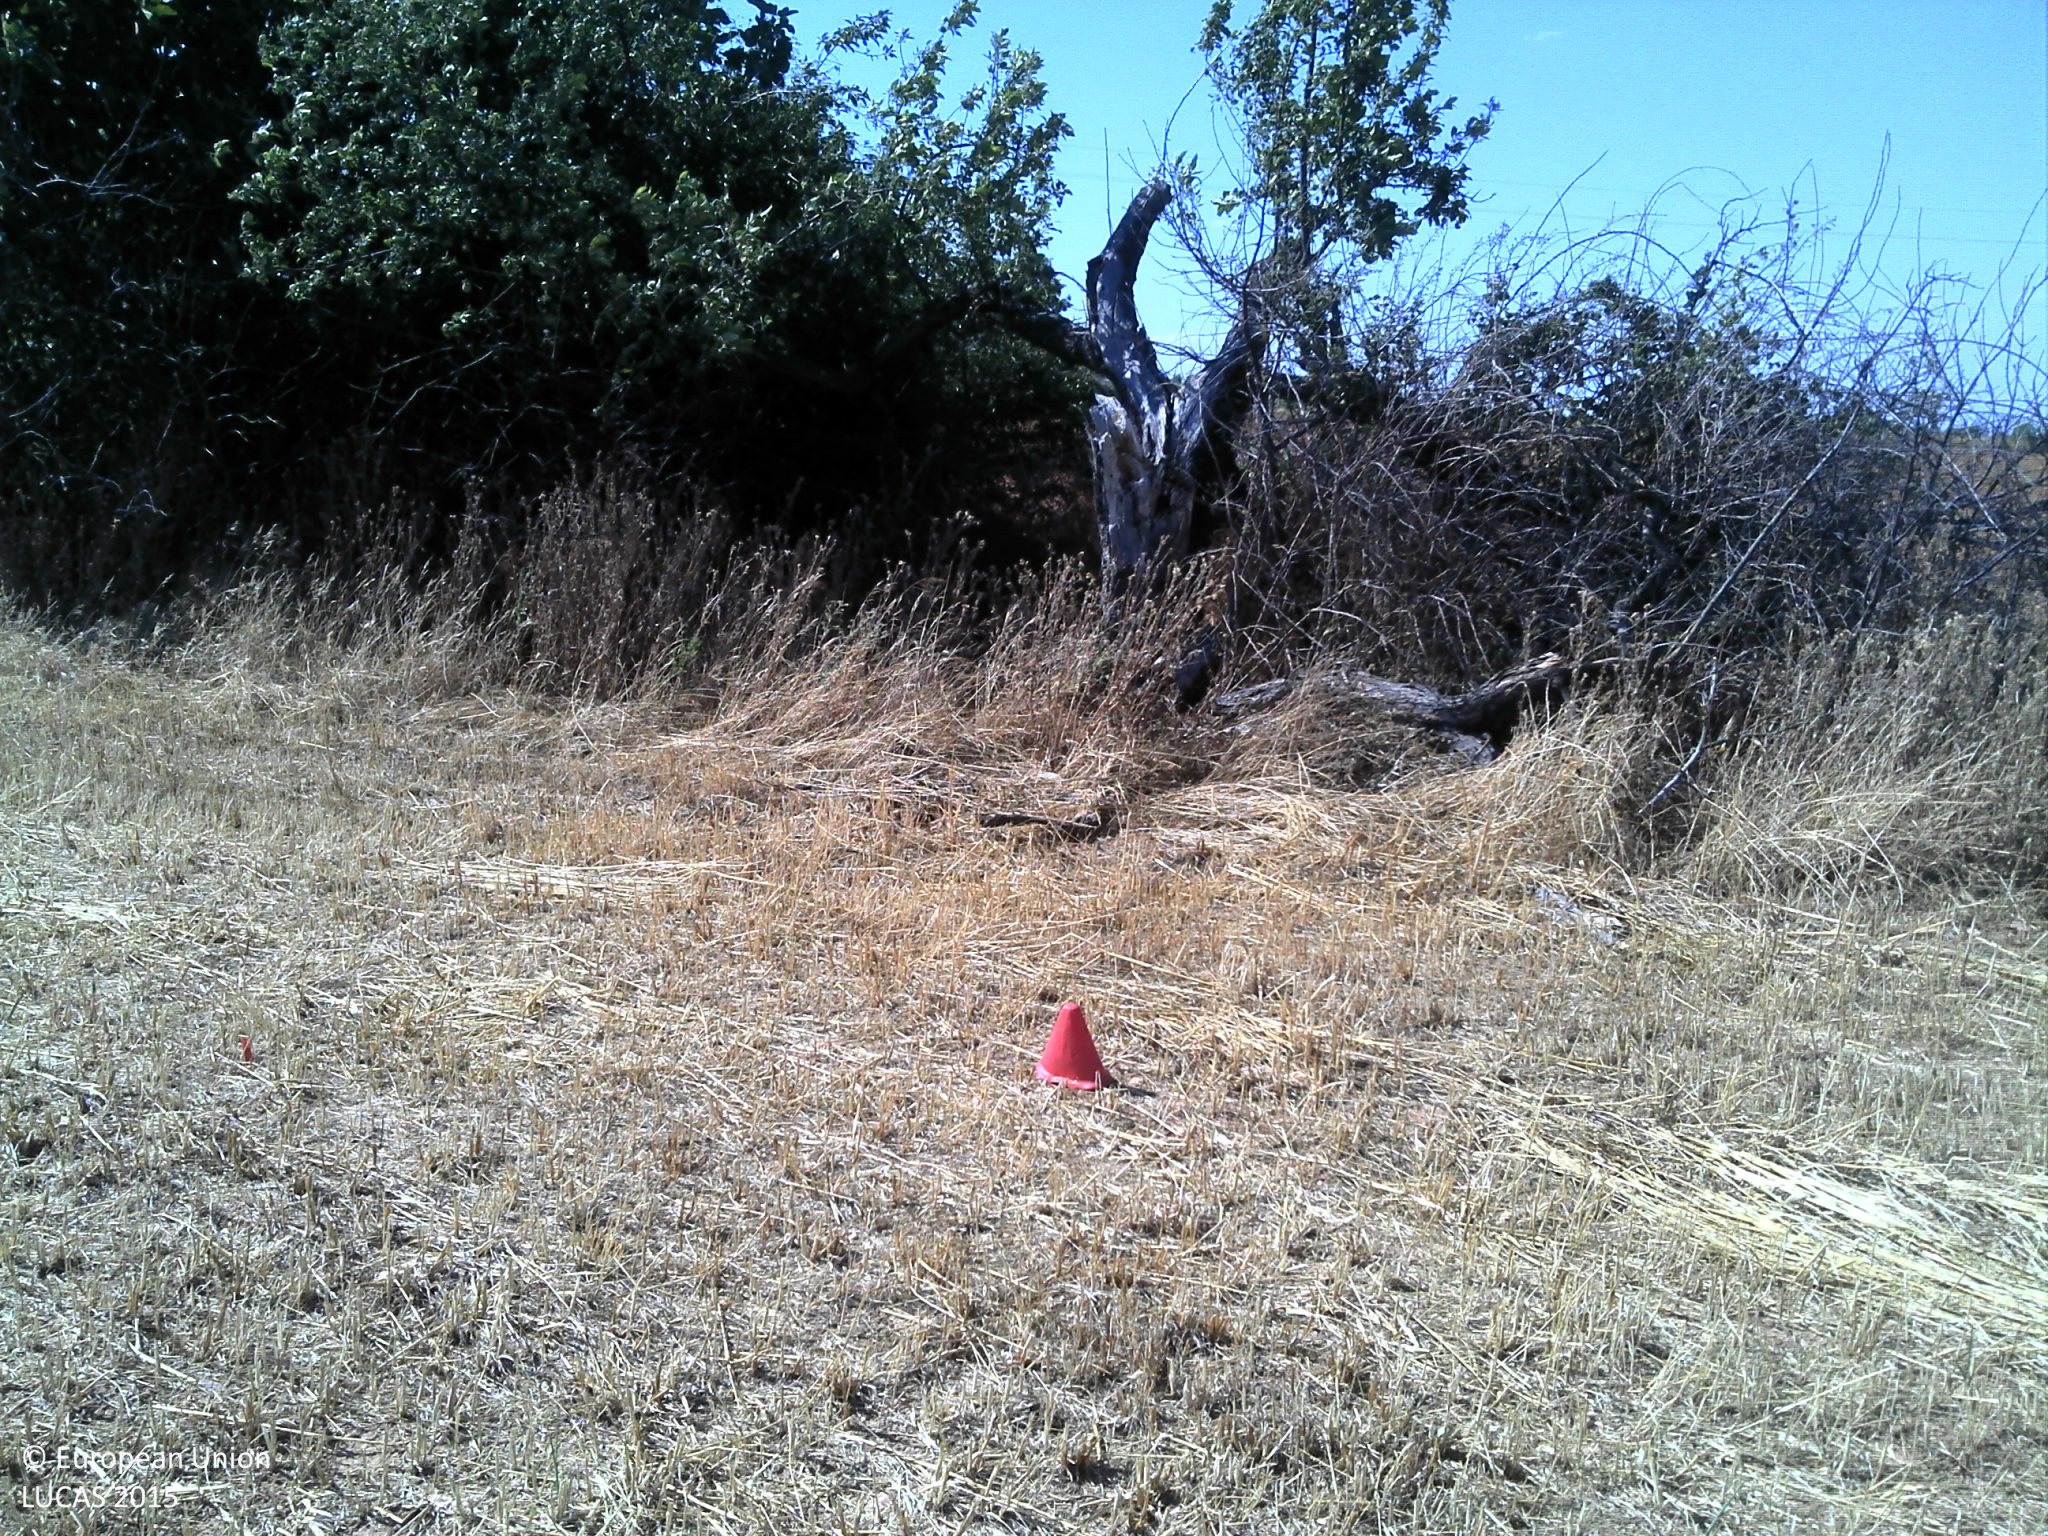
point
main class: Cropland
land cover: Oats
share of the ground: > 75 %
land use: Agriculture (excluding fallow land and kitchen gardens)
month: June
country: PT
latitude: 40.8164
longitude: -6.9011
